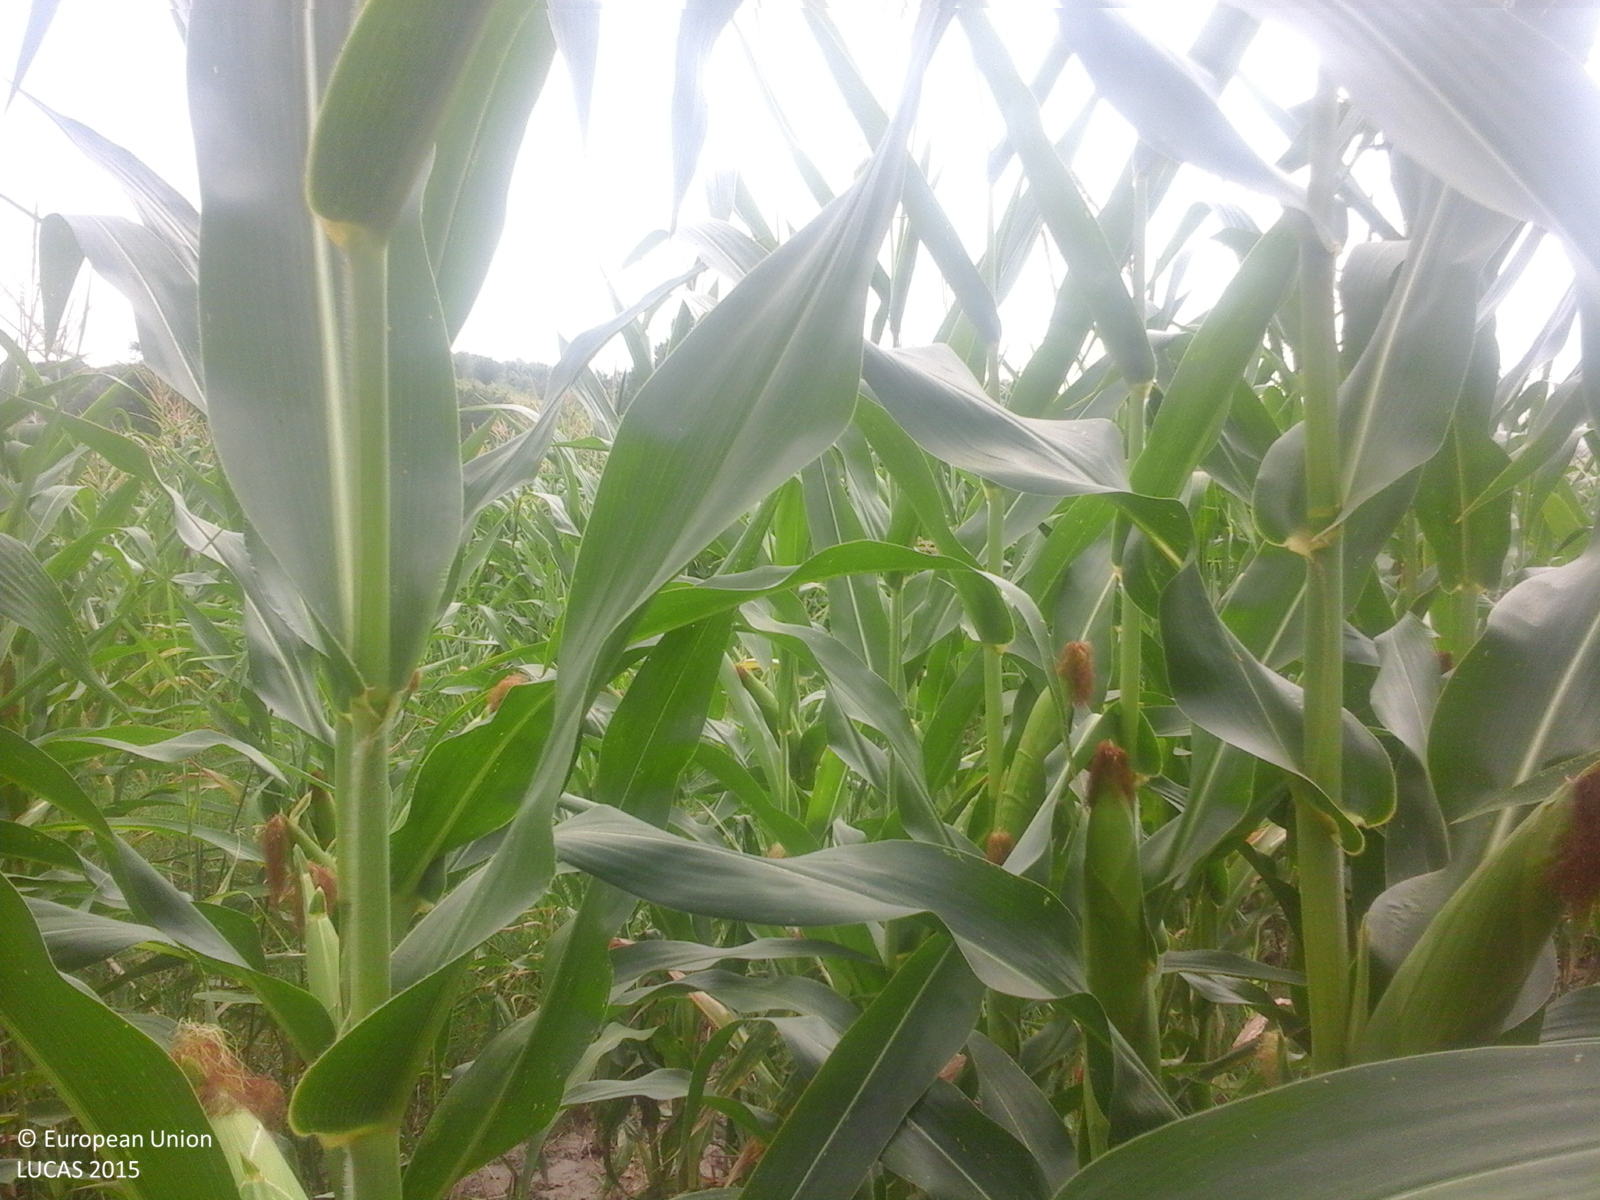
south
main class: Cropland
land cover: Maize
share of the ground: > 75 %
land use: Agriculture (excluding fallow land and kitchen gardens)
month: July
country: RO
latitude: 45.2953
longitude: 28.1644
